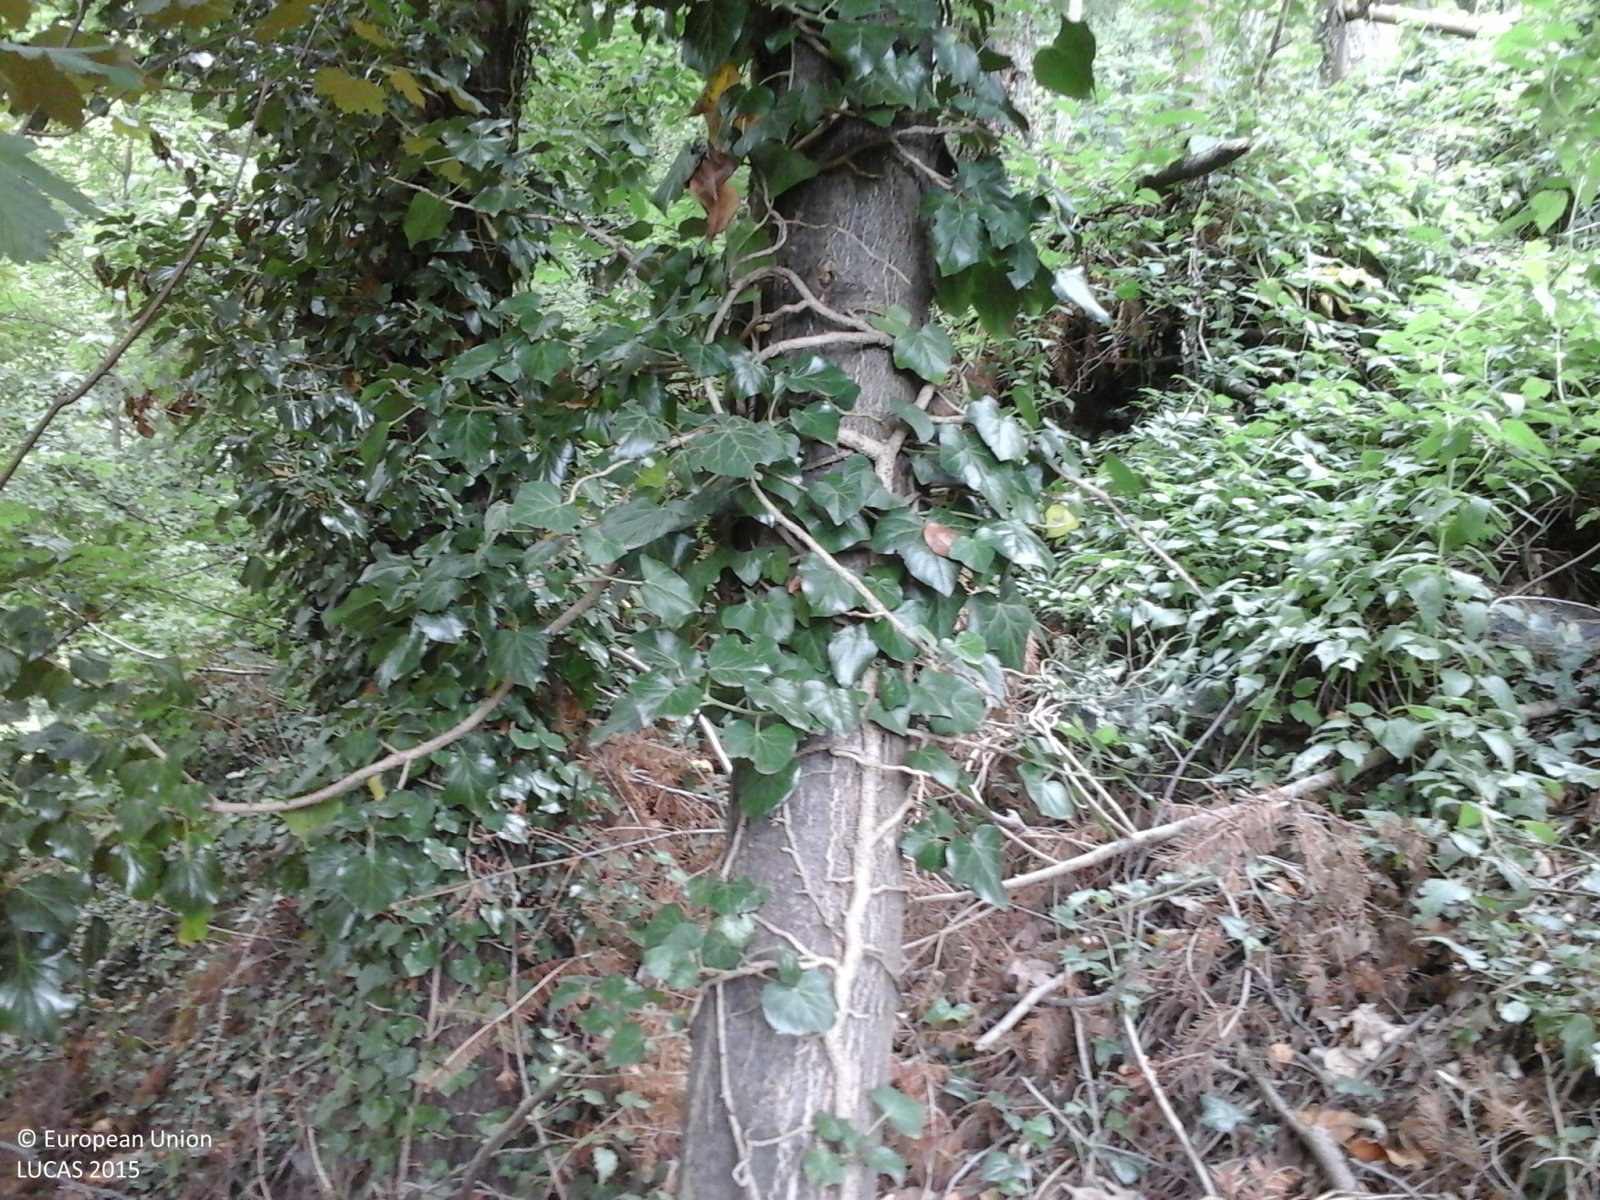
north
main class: Woodland
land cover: Broadleaved woodland
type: thermophilous deciduous forest
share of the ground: > 75 %
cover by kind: broadleaved forest trees 100 %
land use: Forestry
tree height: > 5 m
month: July
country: IT
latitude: 44.9451
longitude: 7.2293
